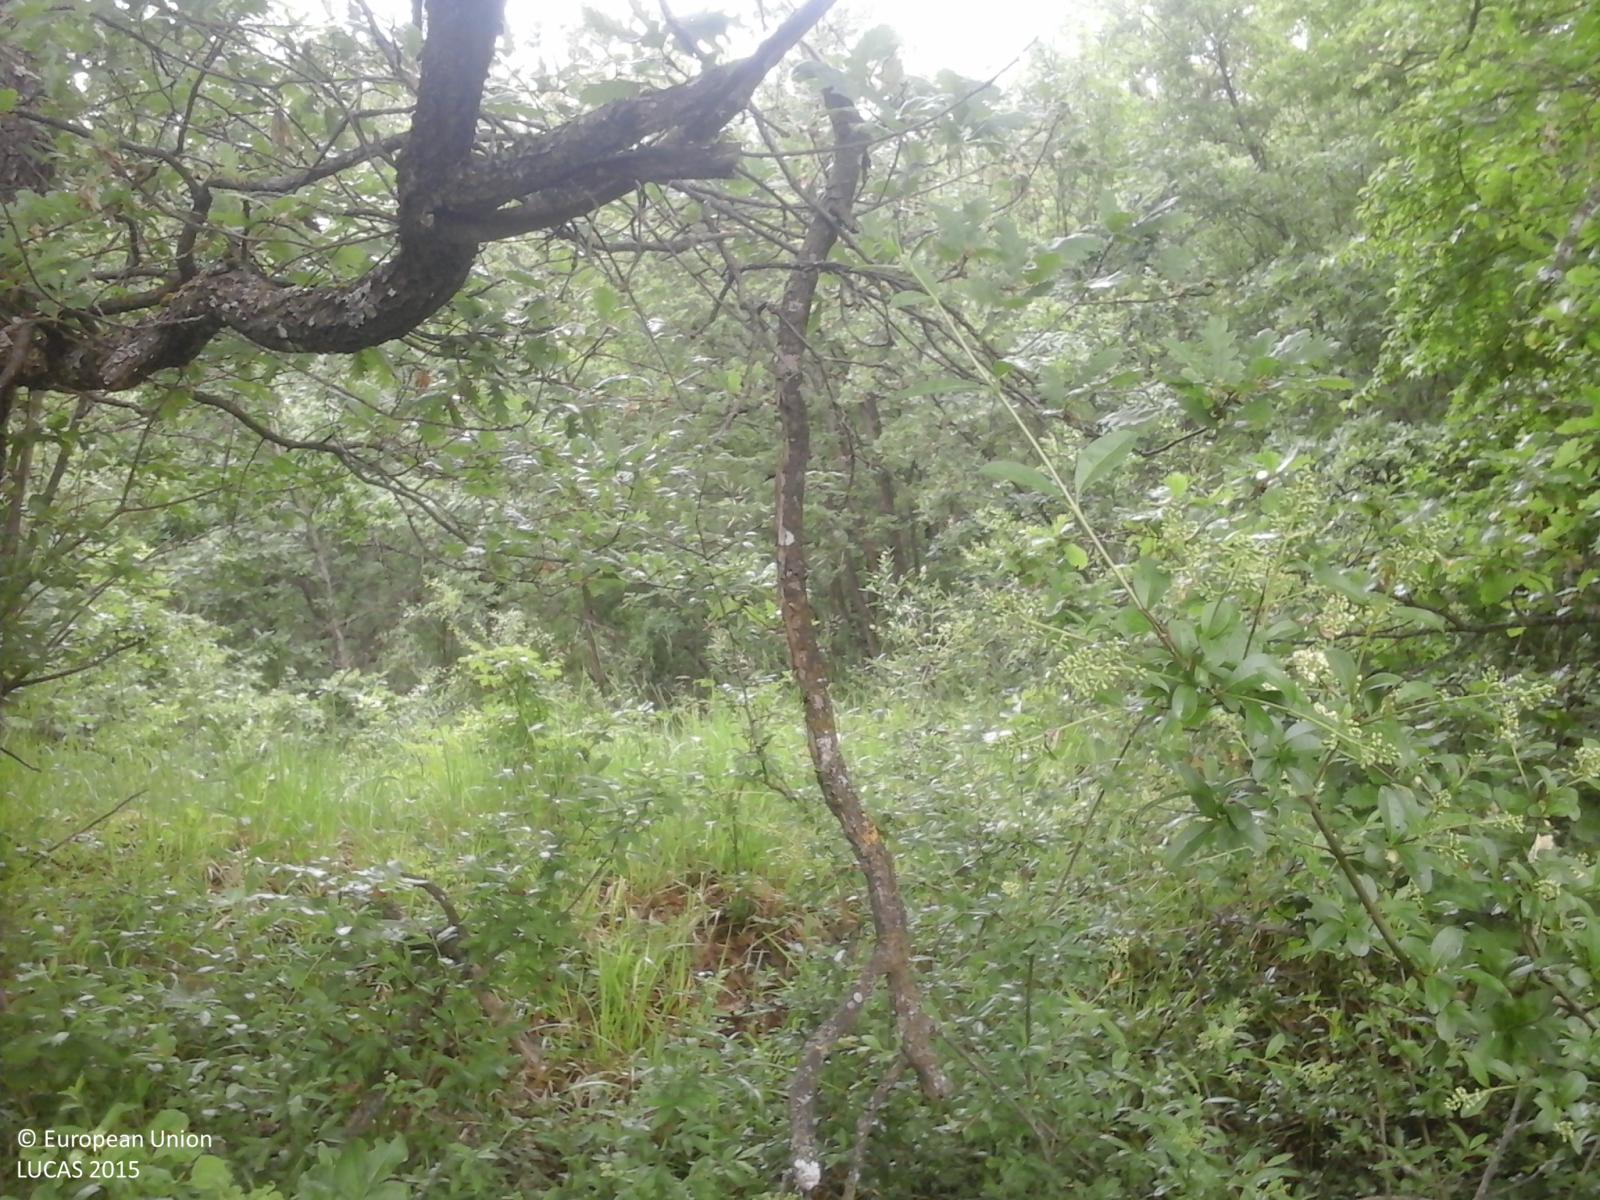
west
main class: Woodland
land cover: Broadleaved woodland
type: thermophilous deciduous forest
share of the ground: > 75 %
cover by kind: broadleaved forest trees 90 %, shrubs 10 %
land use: Forestry
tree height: > 5 m
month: May
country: IT
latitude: 44.2748
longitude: 10.8625
